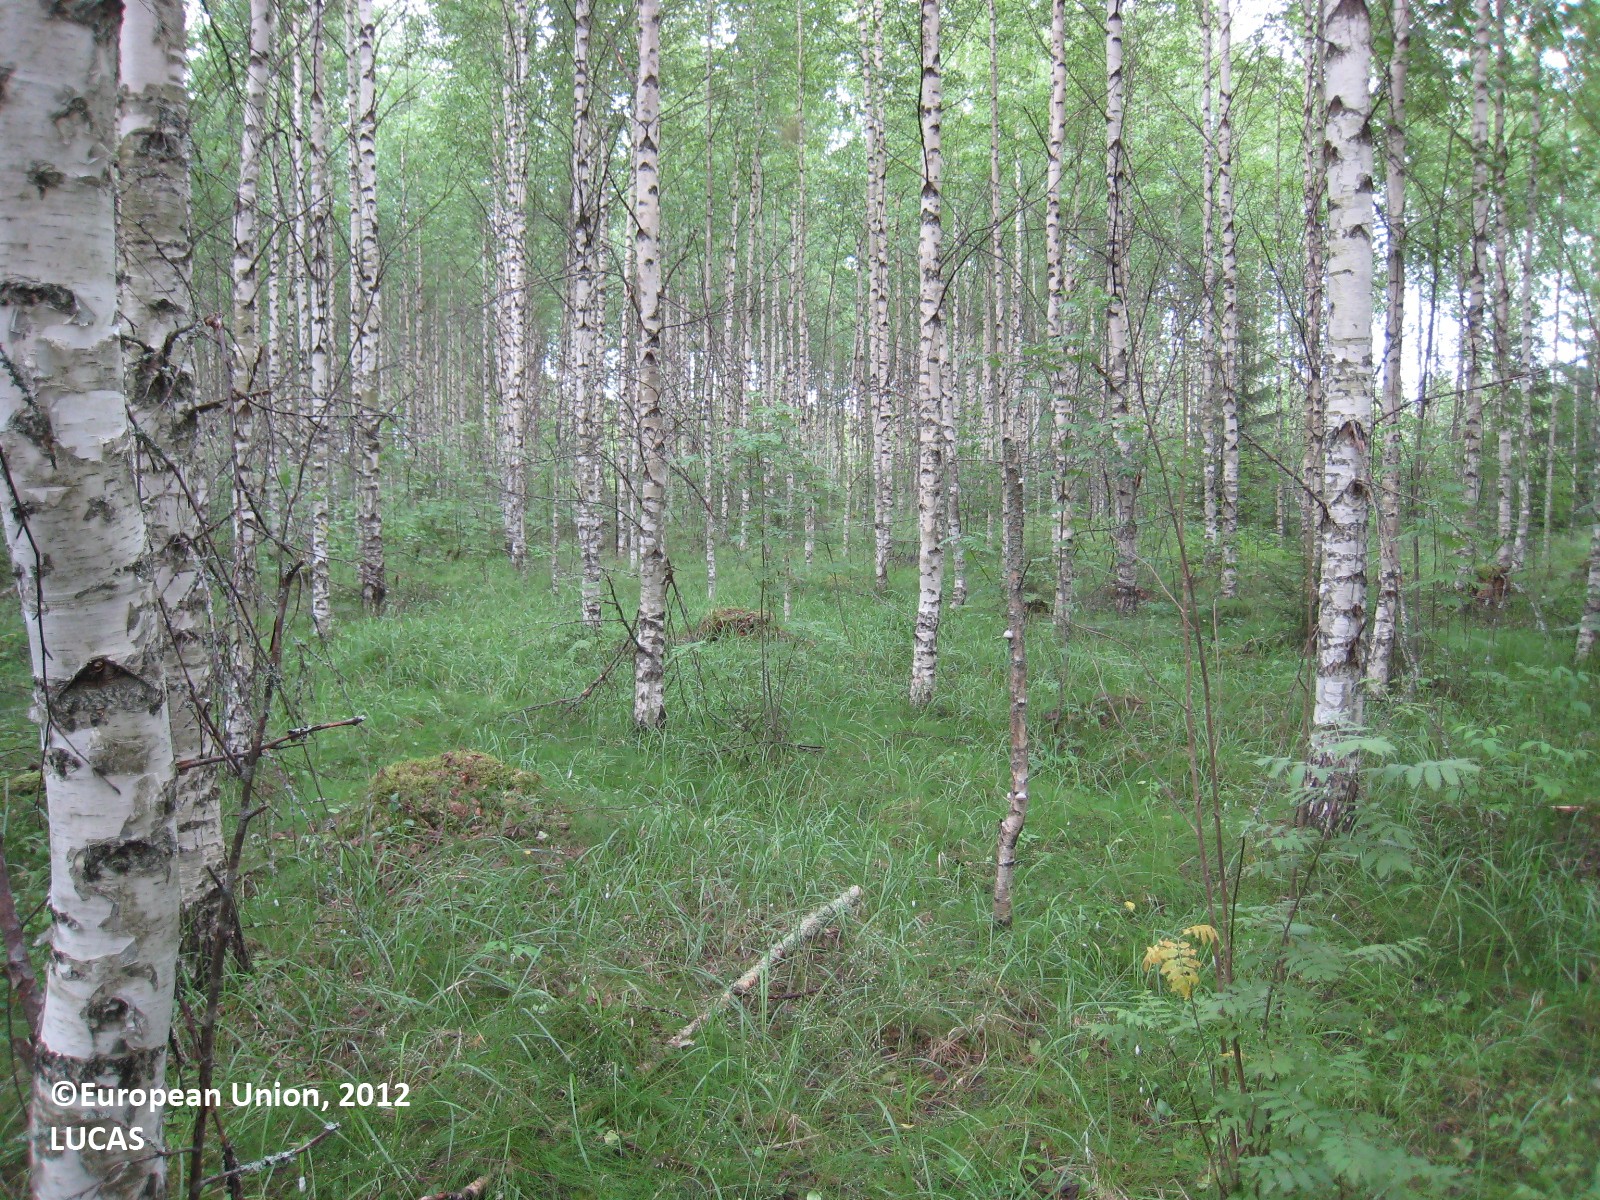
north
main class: Woodland
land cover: Broadleaved woodland
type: non-riverine alder, birch or aspen forest
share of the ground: > 75 %
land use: Forestry
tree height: > 5 m
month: July
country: FI
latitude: 61.7415
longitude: 27.3430
